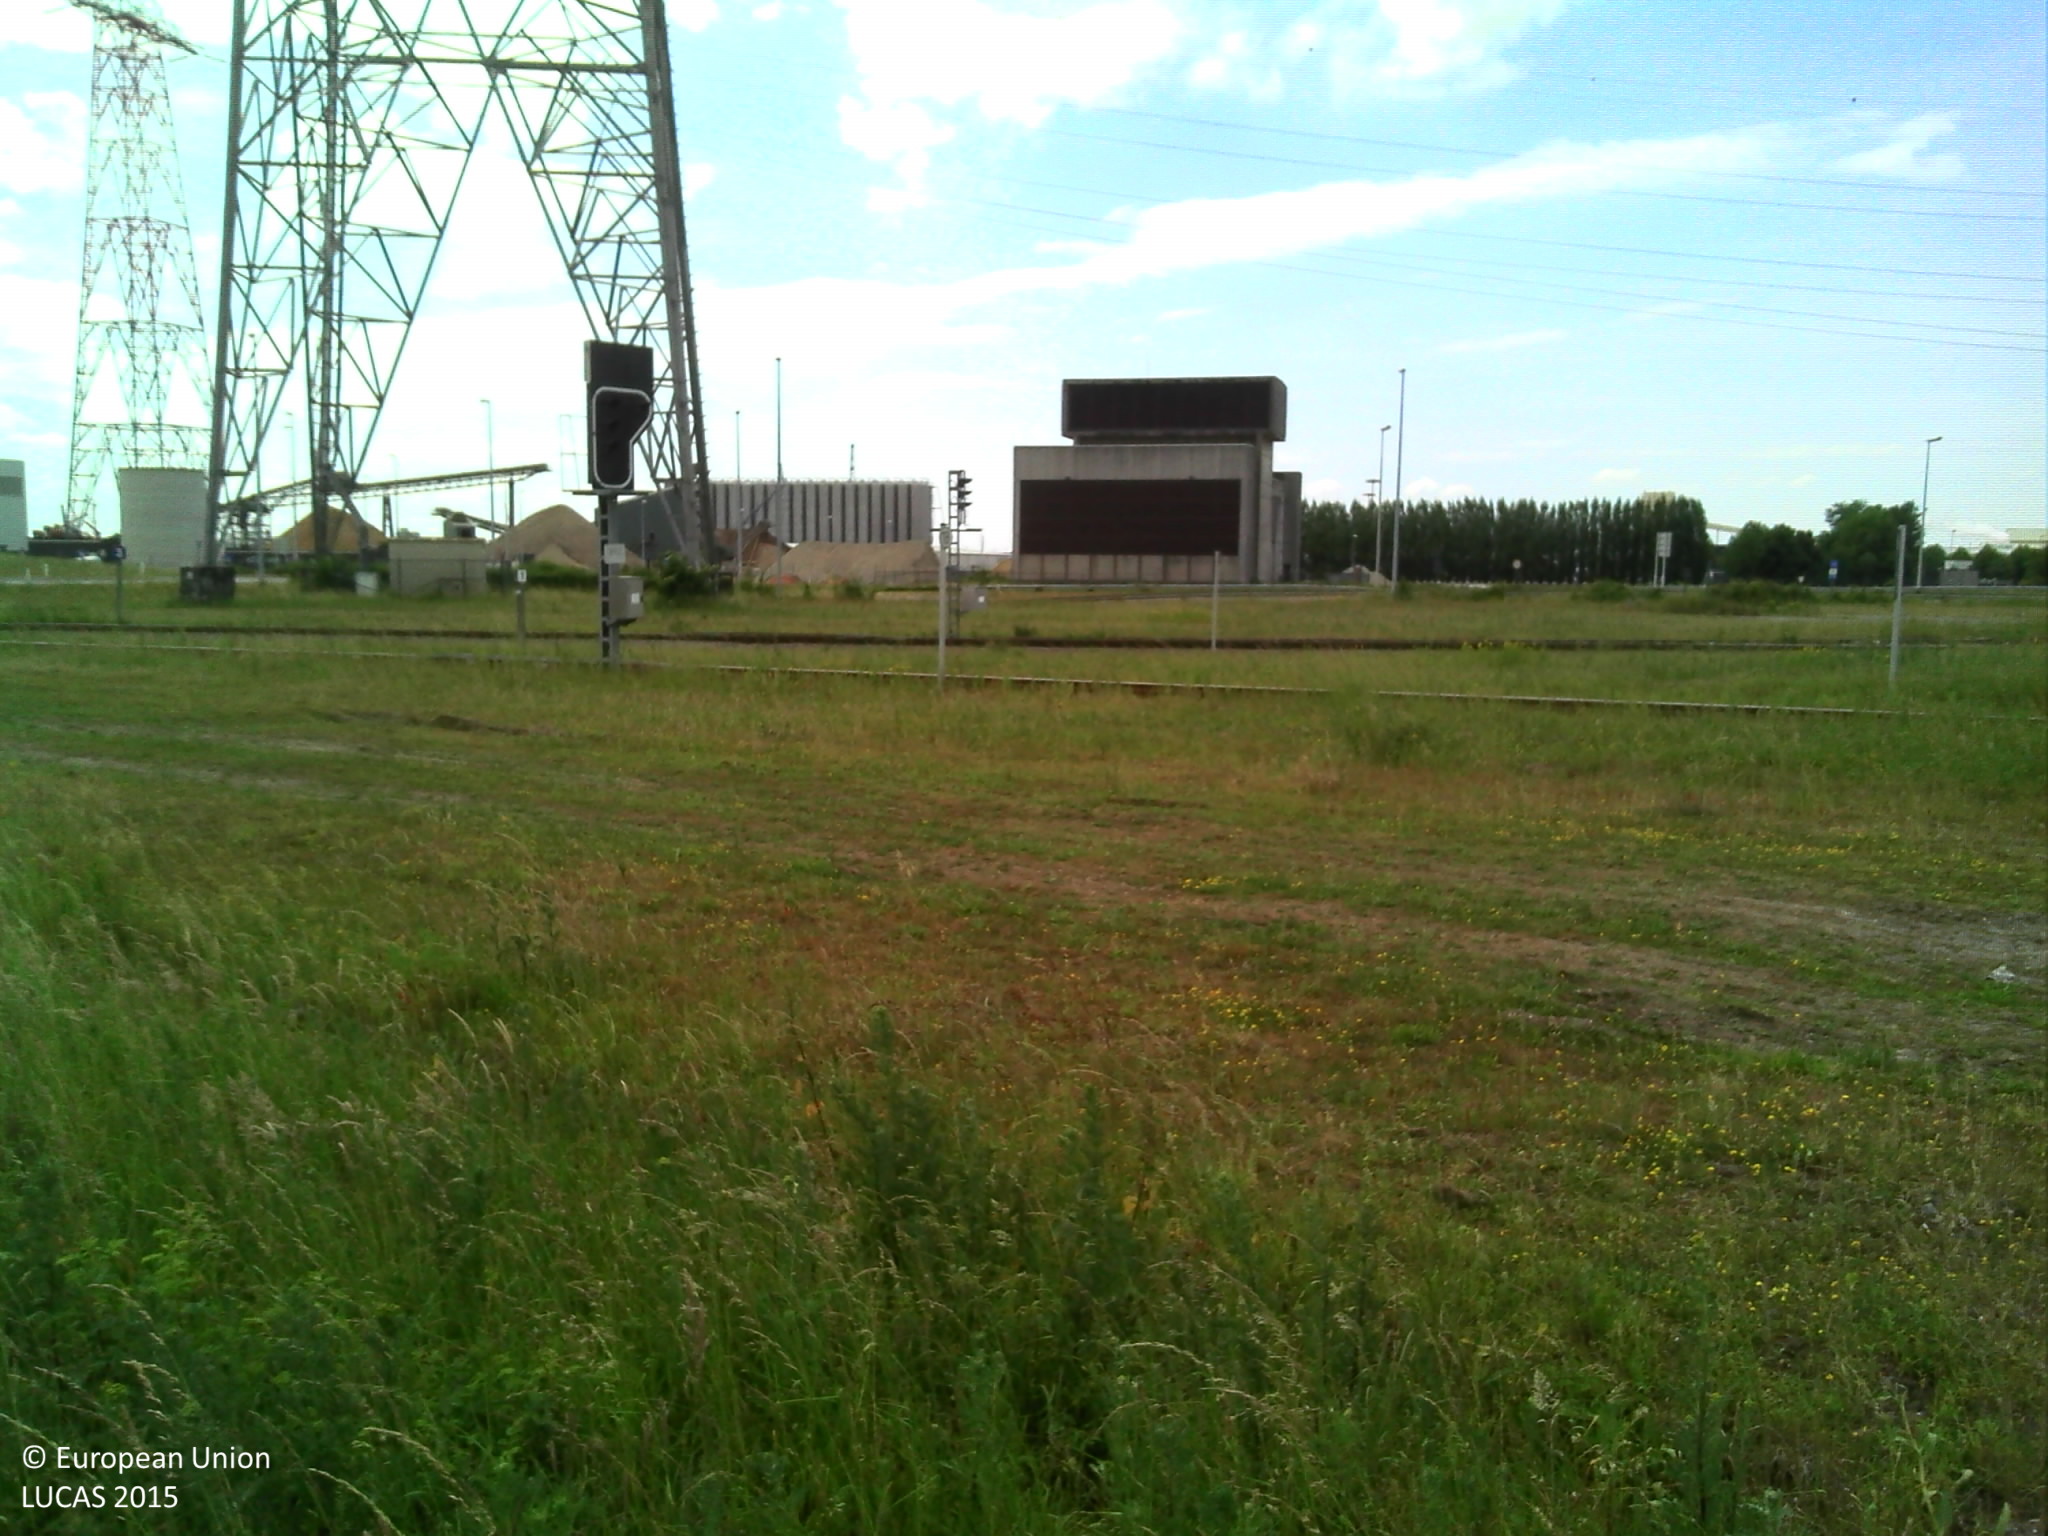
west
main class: Grassland
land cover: Spontaneously vegetated surfaces
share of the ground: > 75 %
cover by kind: herbaceous plants 100 %
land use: Semi-natural and natural areas not in use
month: June
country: BE
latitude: 51.2662
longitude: 4.2766
